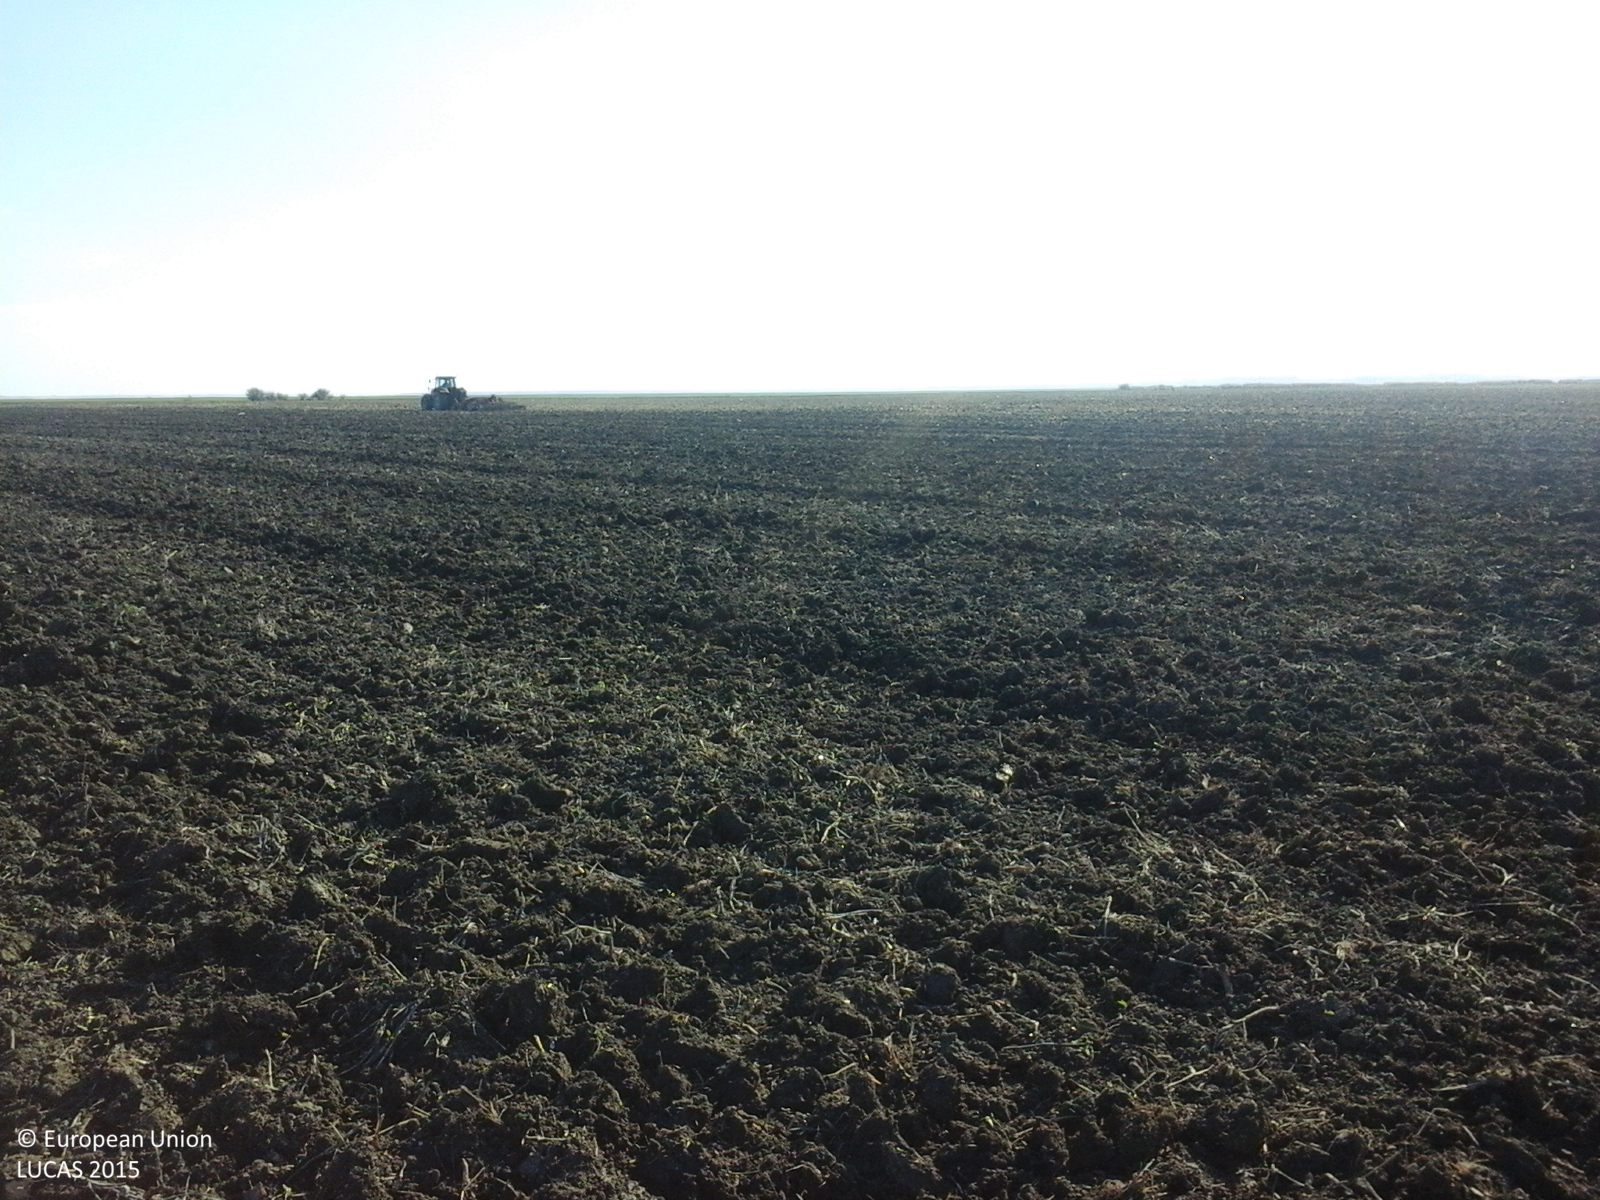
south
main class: Cropland
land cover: Rape and turnip rape
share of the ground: < 10 %
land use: Agriculture (excluding fallow land and kitchen gardens)
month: October
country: RO
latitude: 45.4061
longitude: 27.4109
